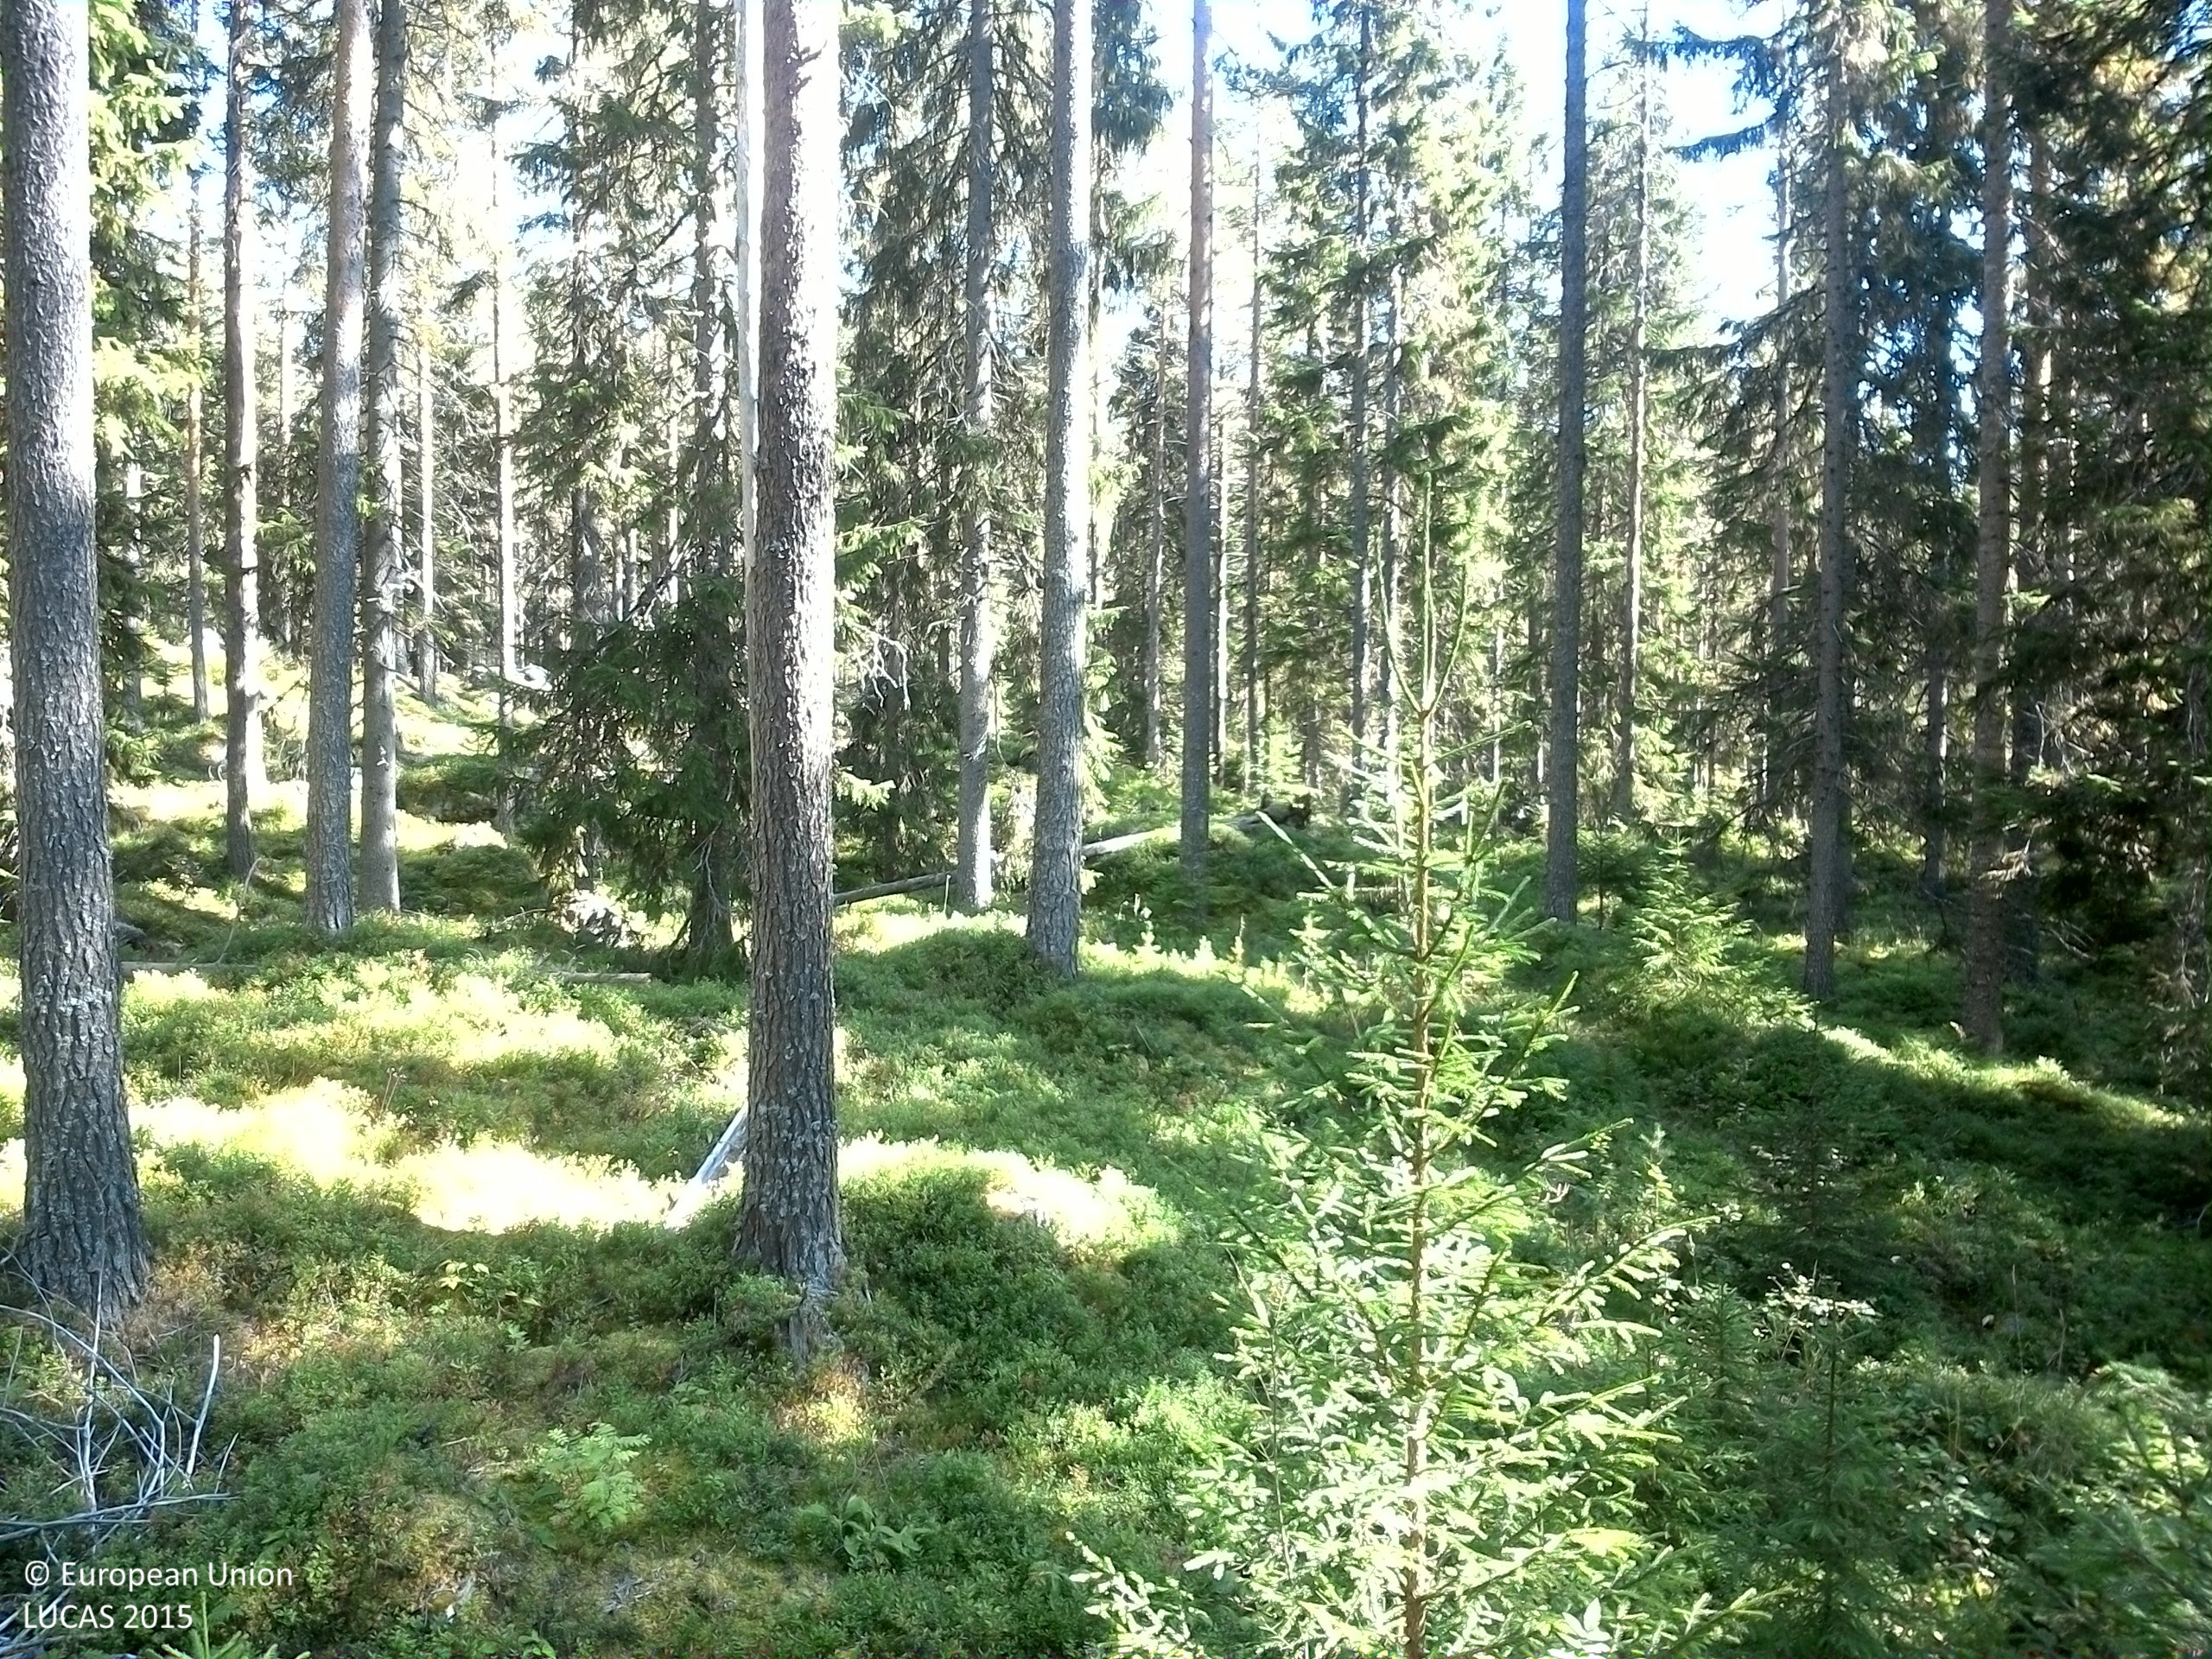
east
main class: Woodland
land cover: Pine dominated coniferous woodland
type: boreal forest
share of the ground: 50 - 75 %
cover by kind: coniferous forest trees 50 %, shrubs 35 %, lichens and mosses 15 %
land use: Forestry
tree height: > 5 m
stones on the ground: 10 - 25 %
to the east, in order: Pine dominated coniferous woodland; Other coniferous woodland; Pine dominated coniferous woodland
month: September
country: SE
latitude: 61.7551
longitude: 14.9274
